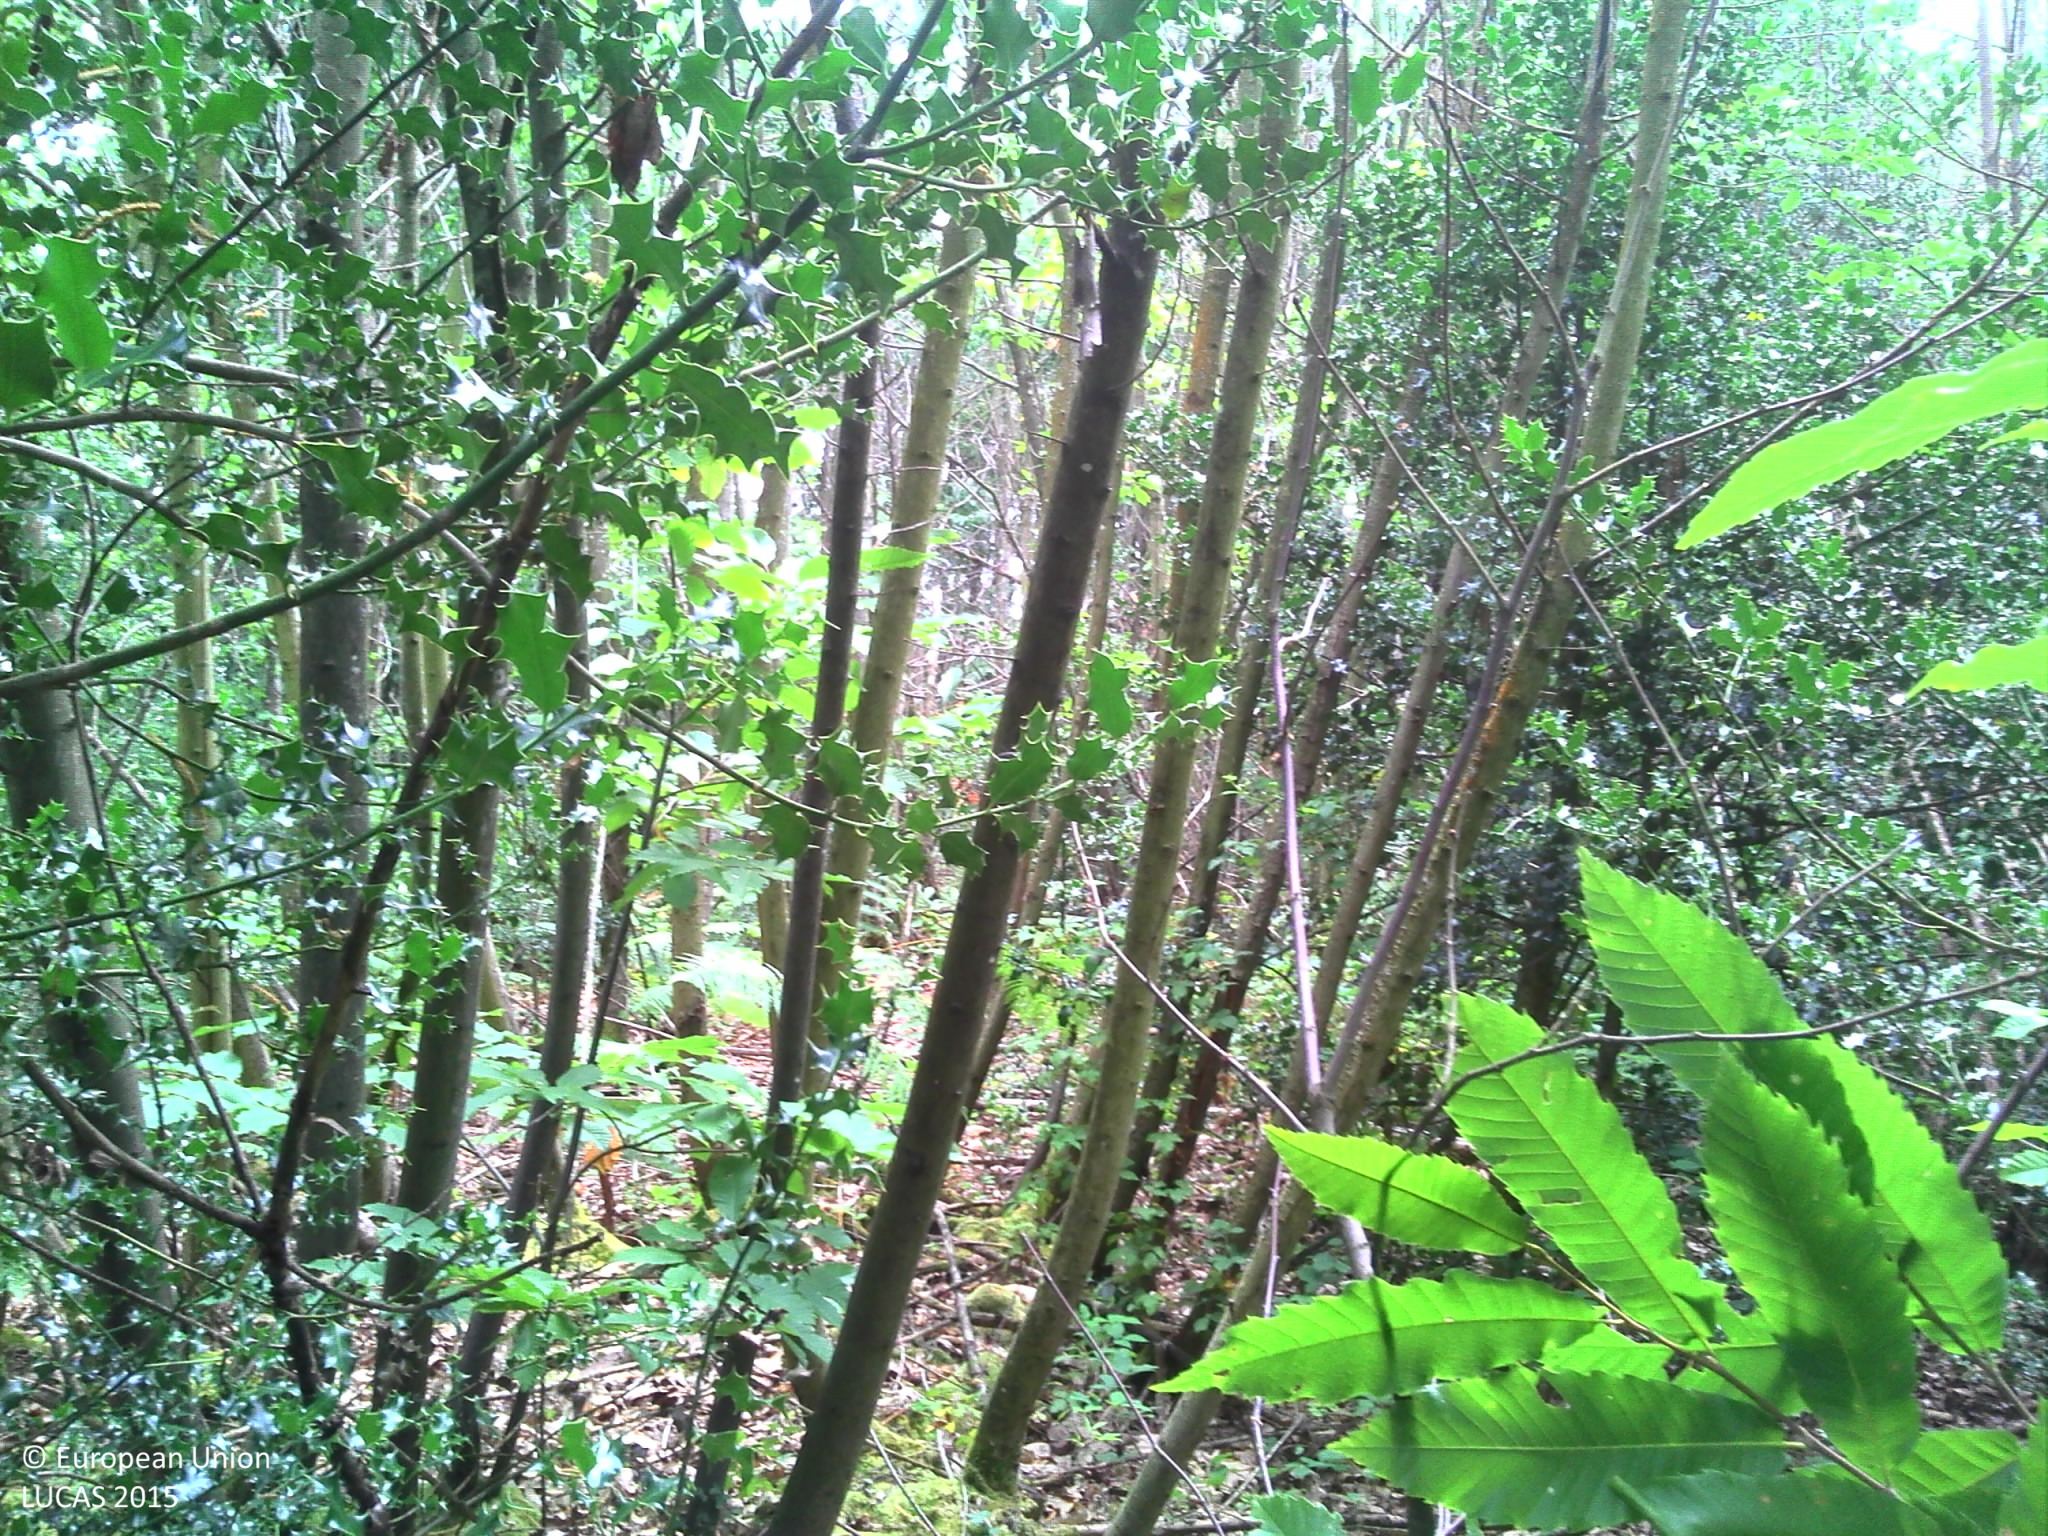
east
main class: Woodland
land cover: Broadleaved woodland
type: acidophilous oak and oak-birch forest
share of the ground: > 75 %
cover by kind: broadleaved forest trees 95 %, herbaceous plants 5 %
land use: Forestry
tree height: > 5 m
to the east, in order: Broadleaved woodland; Ditches and canals; Grass margins; Tracks; Grass margins; Ditches and canals; Broadleaved woodland; Tracks; Broadleaved woodland; Fences; Grassland without tree/shrub cover; Electric lines; Grassland without tree/shrub cover; Fences; Abandoned hedges; Electric lines; Ditches and canals; Grass margins; Paved roads, cycling and walking lanes; Grass margins; Ditches and canals; Pine dominated coniferous woodland; Ditches and canals; Grass margins; Paved roads, cycling and walking lanes; Grass margins; Ditches and canals; Shrubland with sparse tree cover; Maize
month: July
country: FR
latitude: 47.5856
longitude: -1.8151
